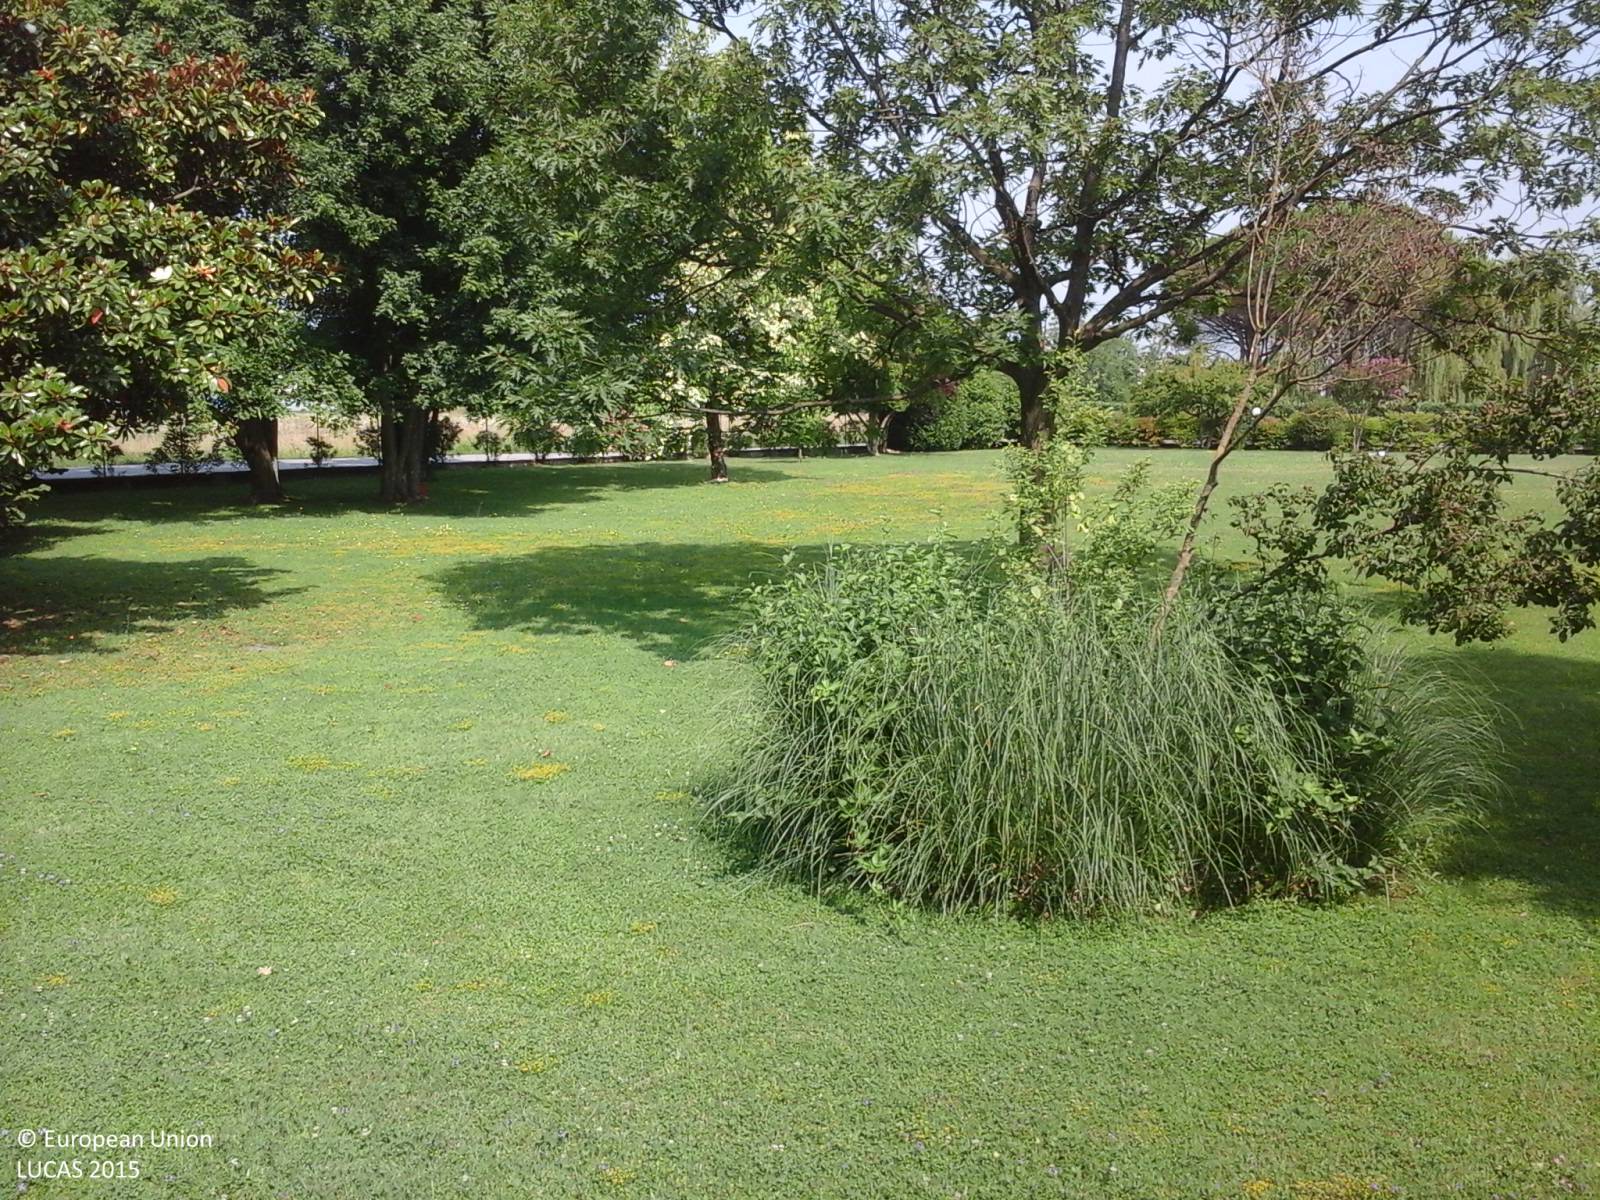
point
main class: Grassland
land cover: Grassland with sparse tree/shrub cover
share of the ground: > 75 %
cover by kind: herbaceous plants 85 %, shrubs 10 %, coniferous forest trees 5 %
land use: Residential
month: July
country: IT
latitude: 45.9568
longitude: 12.6932
